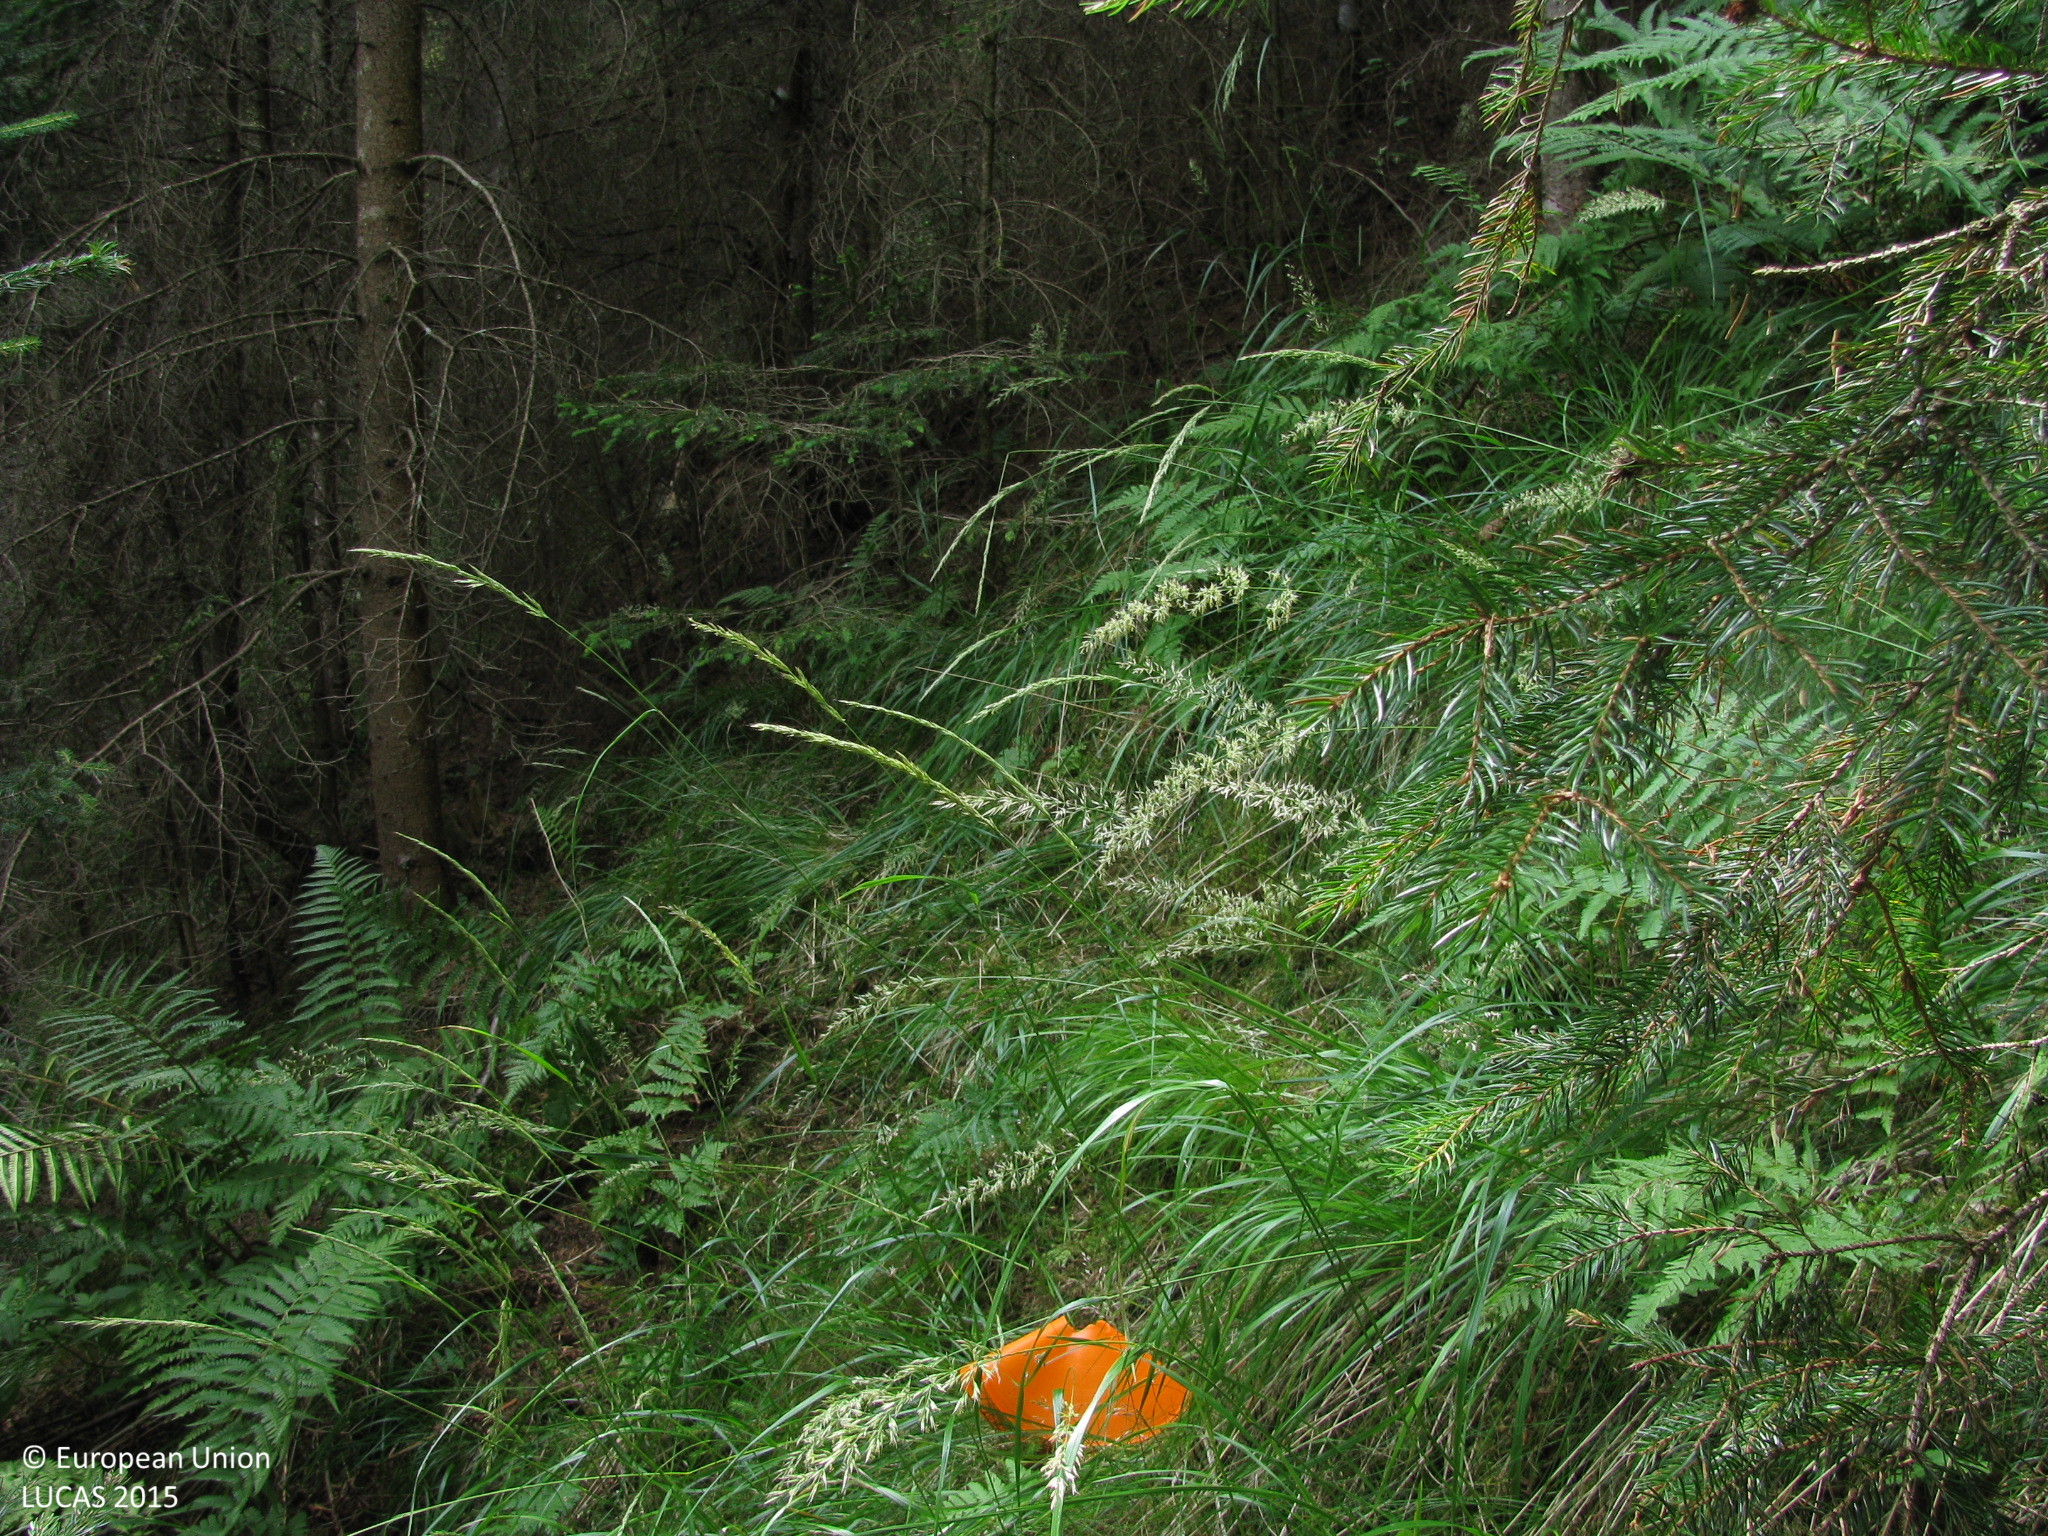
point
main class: Woodland
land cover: Spruce dominated coniferous woodland
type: alpine coniferous forest
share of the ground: > 75 %
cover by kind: coniferous forest trees 70 %, herbaceous plants 25 %, lichens and mosses 5 %
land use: Forestry
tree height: > 5 m
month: July
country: AT
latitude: 47.1124
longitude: 14.7300
